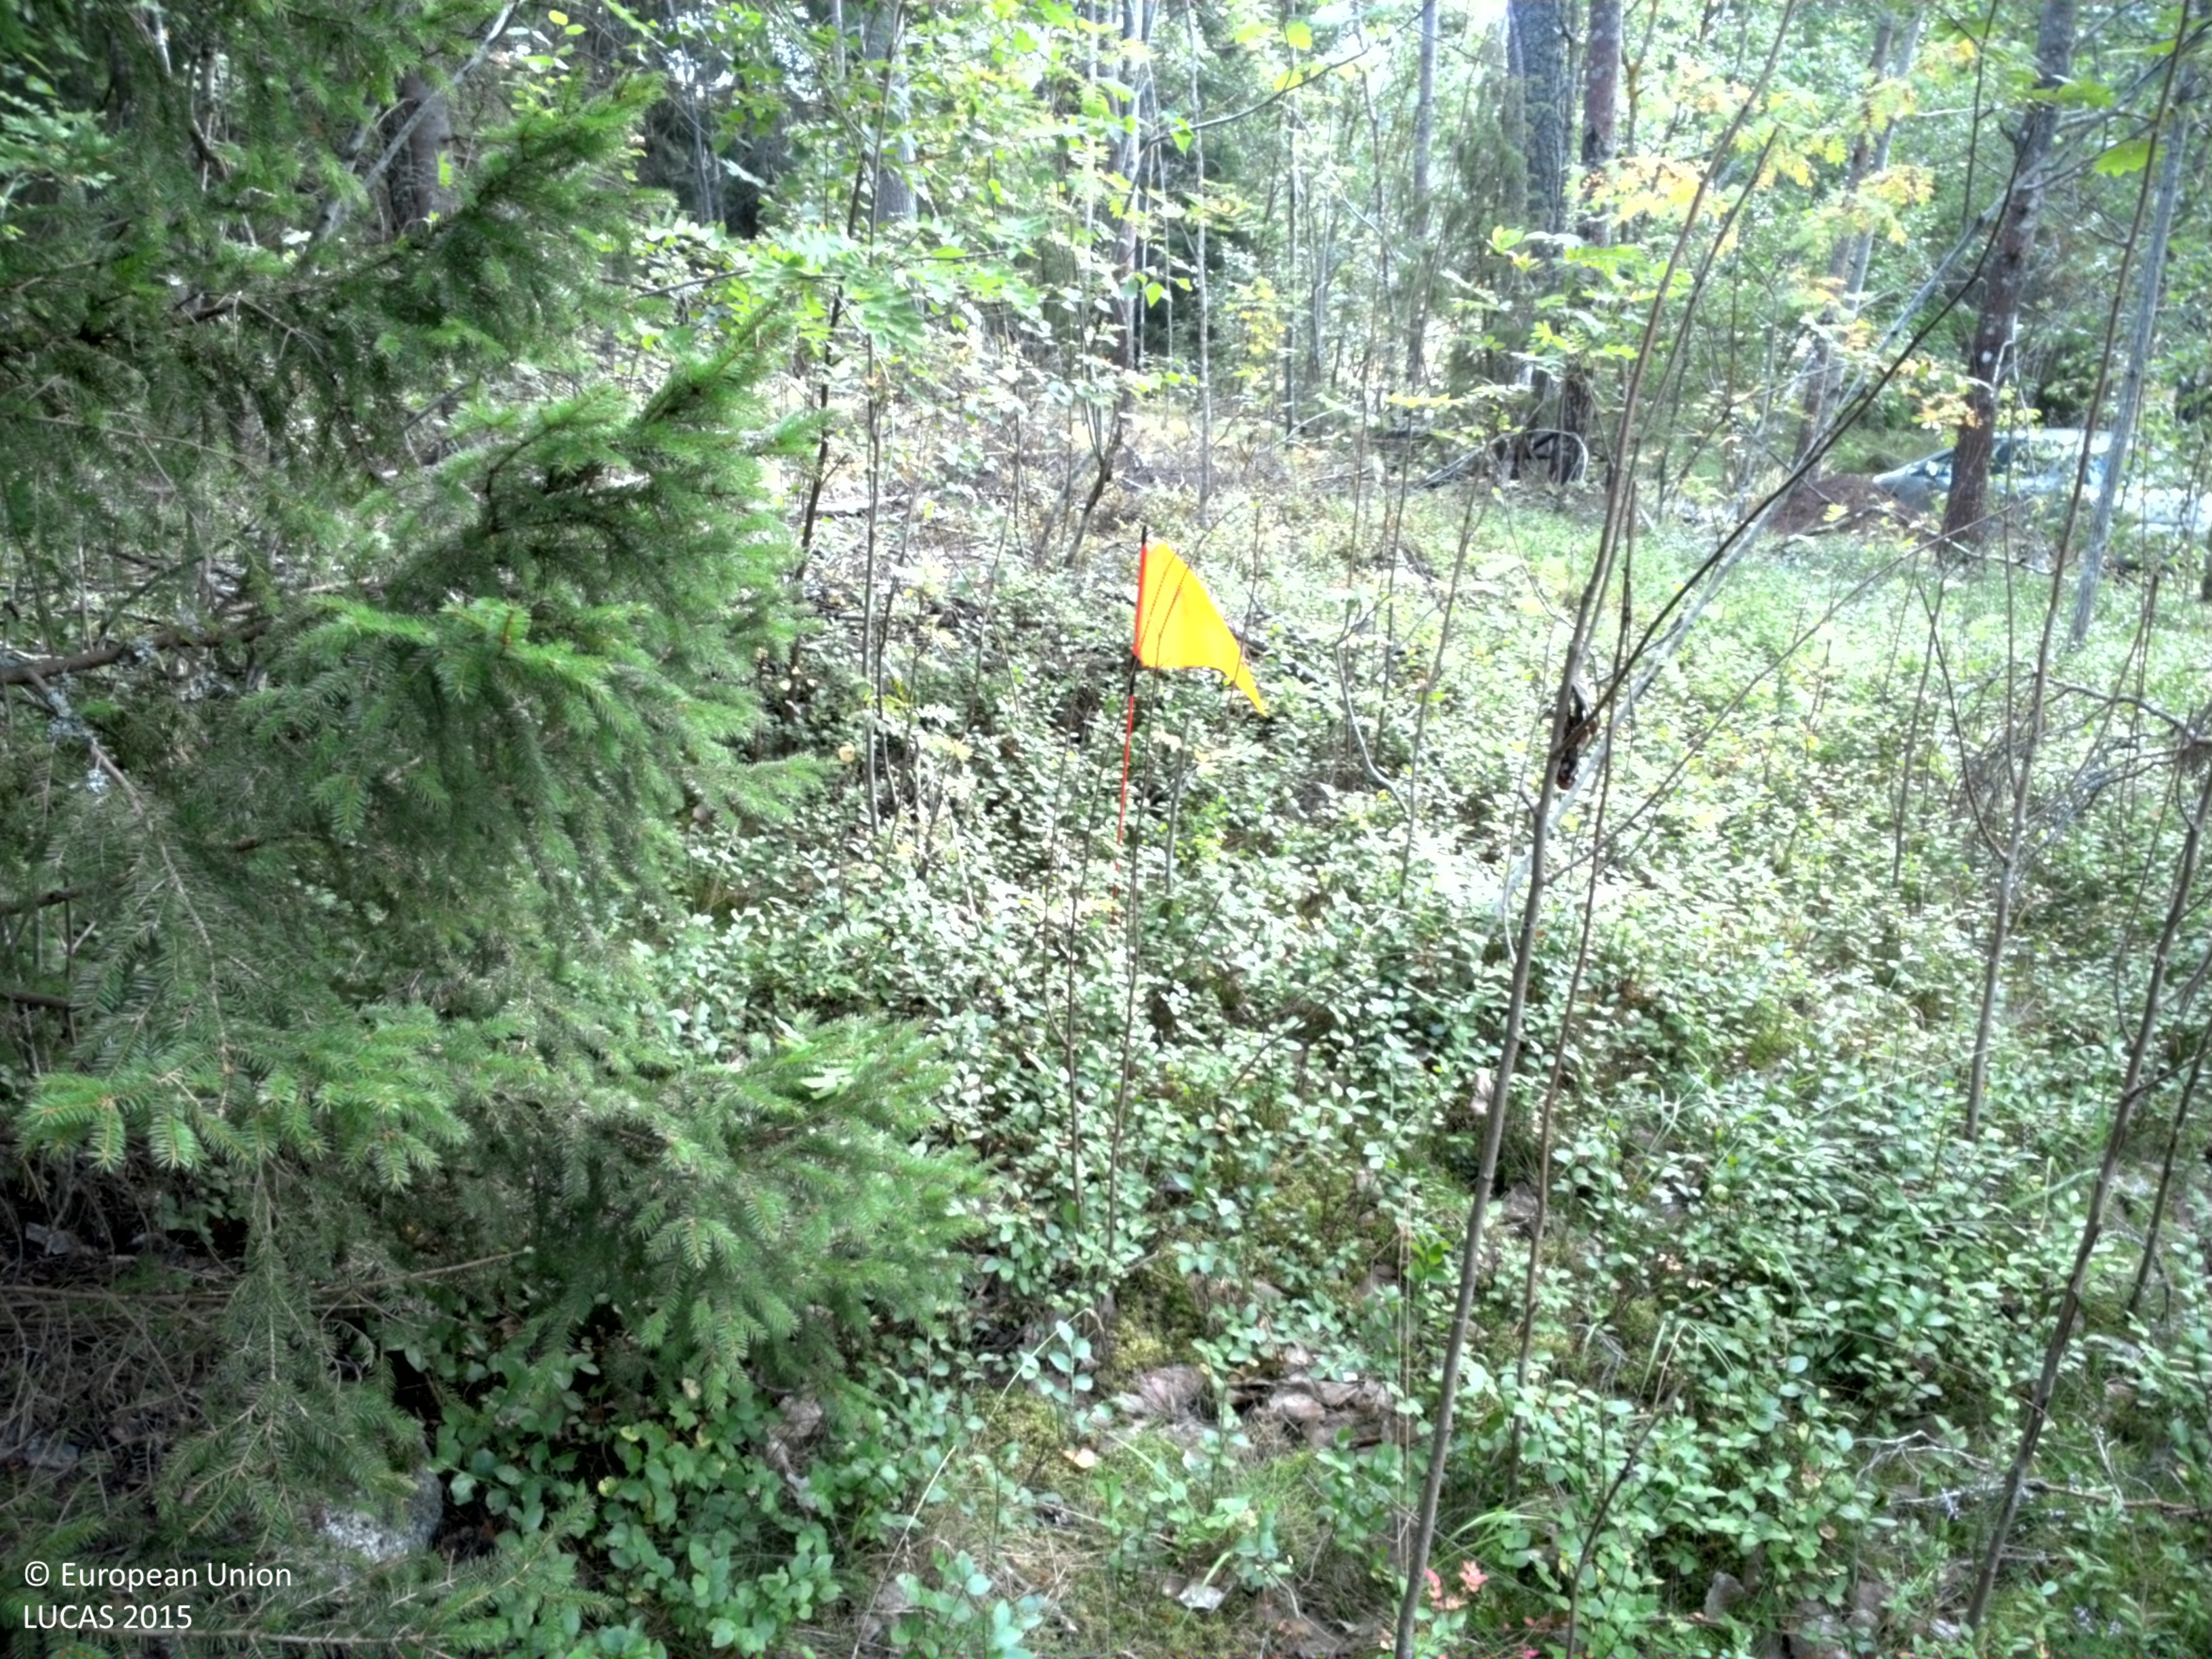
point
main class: Woodland
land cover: Spruce dominated mixed woodland
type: boreal forest
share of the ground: 50 - 75 %
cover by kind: coniferous forest trees 45 %, herbaceous plants 20 %, lichens and mosses 20 %, broadleaved forest trees 15 %
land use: Forestry
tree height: > 5 m
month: August
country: SE
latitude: 60.0090
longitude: 17.6520
